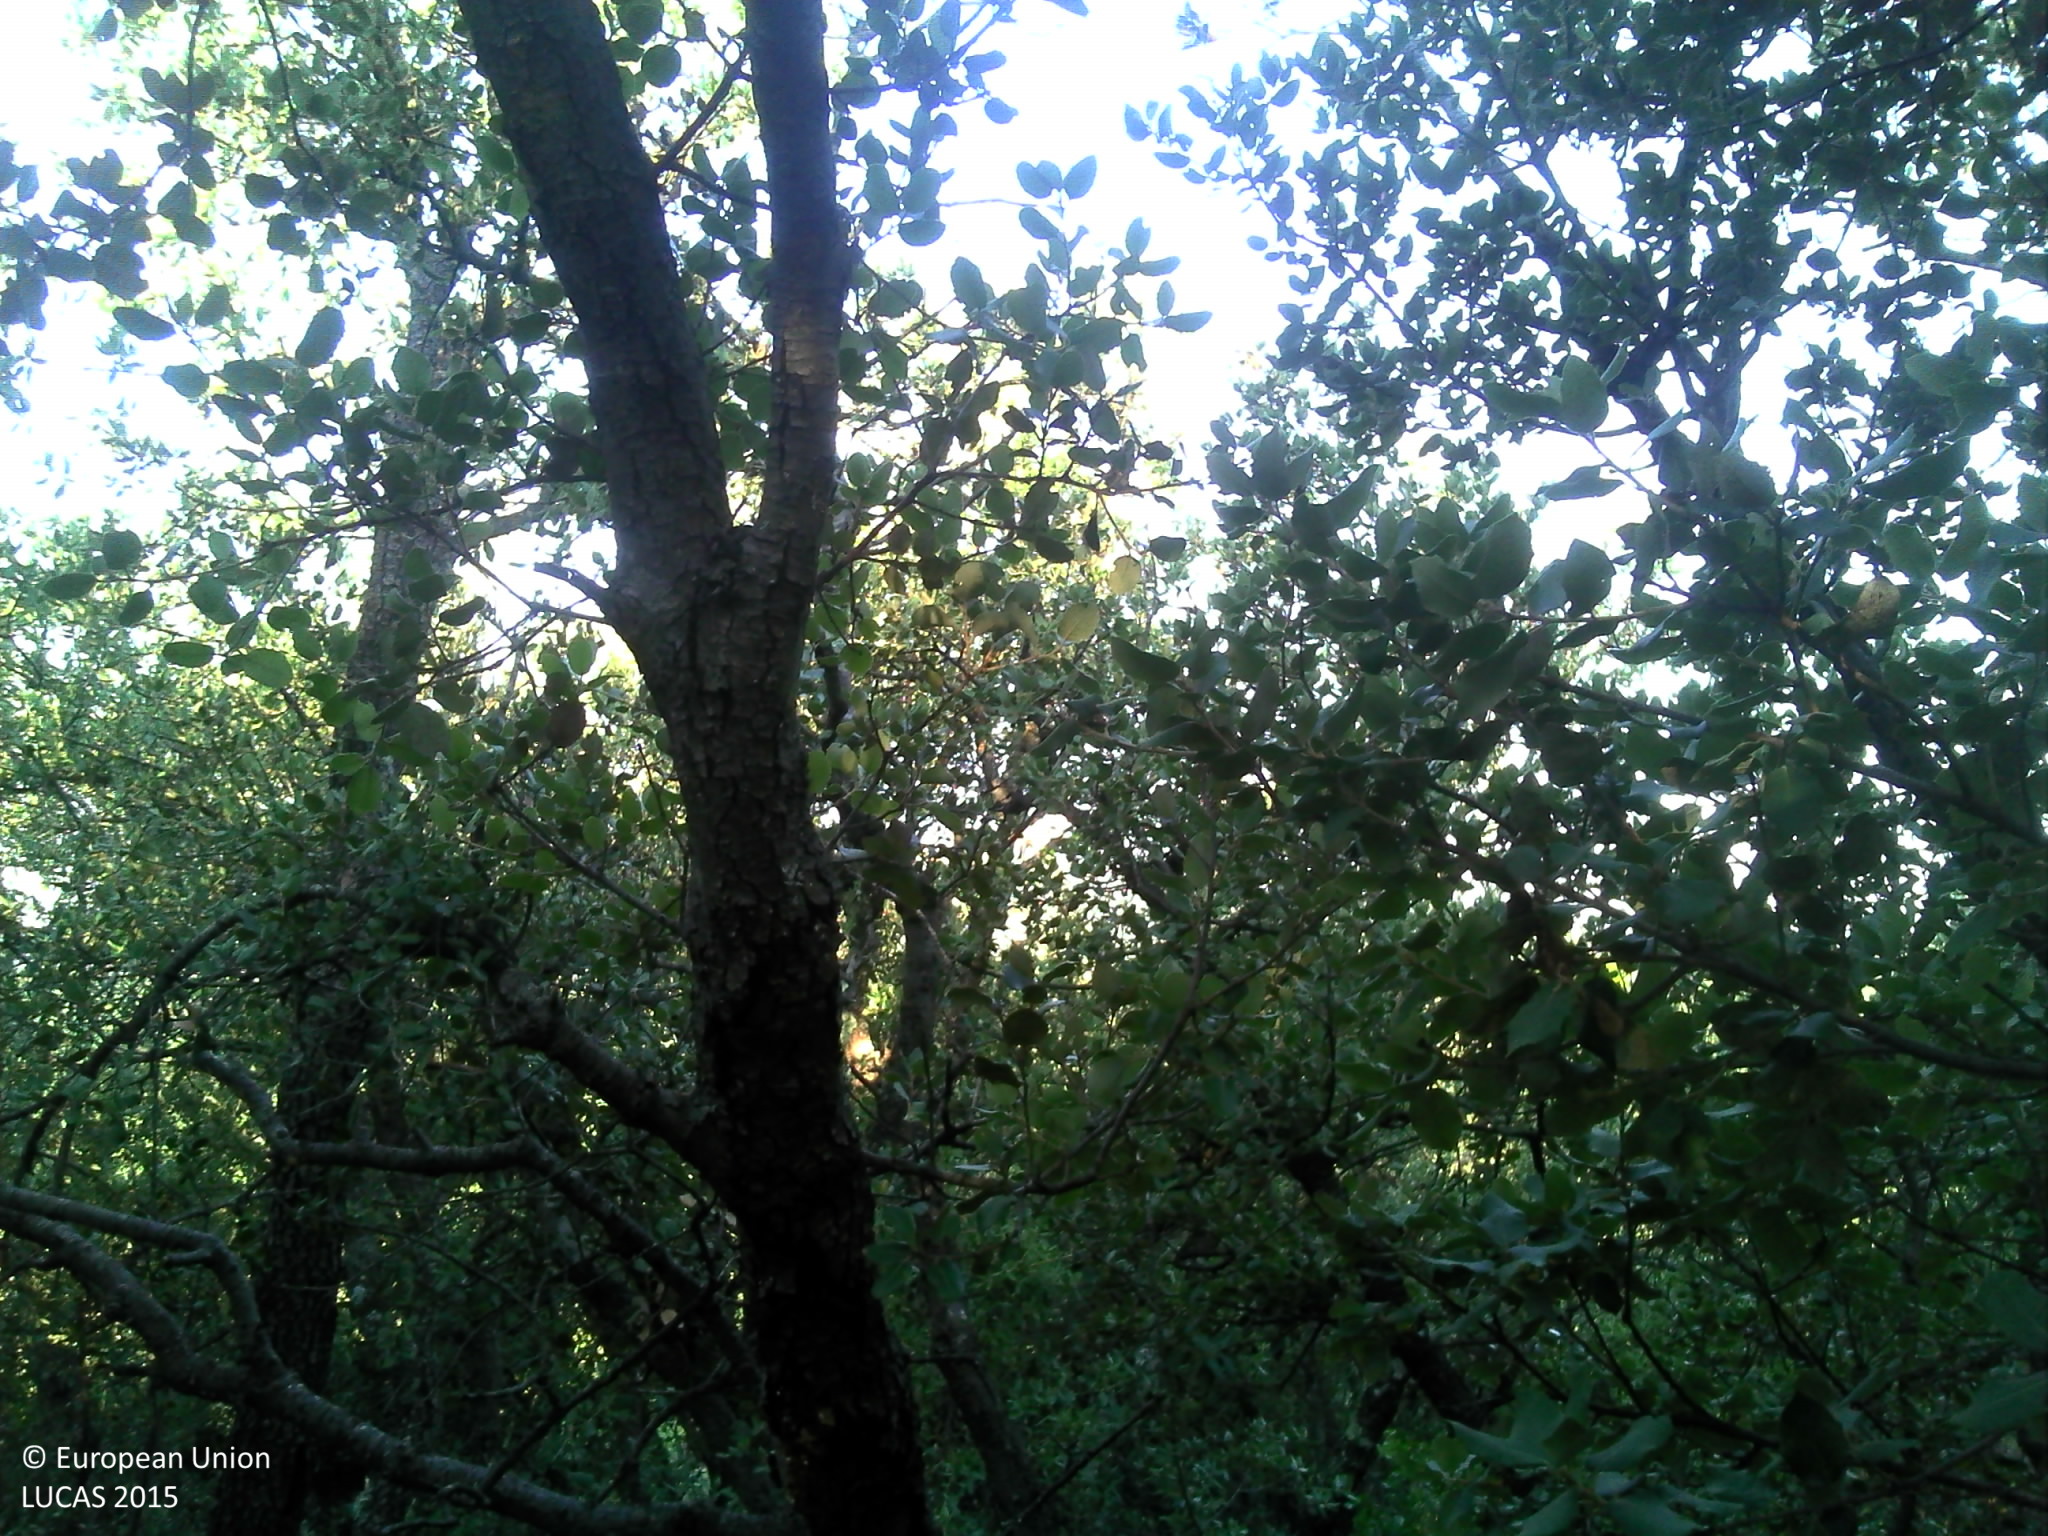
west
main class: Woodland
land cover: Broadleaved woodland
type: thermophilous deciduous forest
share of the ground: > 75 %
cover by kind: broadleaved forest trees 80 %, shrubs 20 %
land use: Semi-natural and natural areas not in use
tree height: > 5 m
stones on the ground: > 50 %
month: August
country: FR
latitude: 43.5405
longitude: 5.7397
